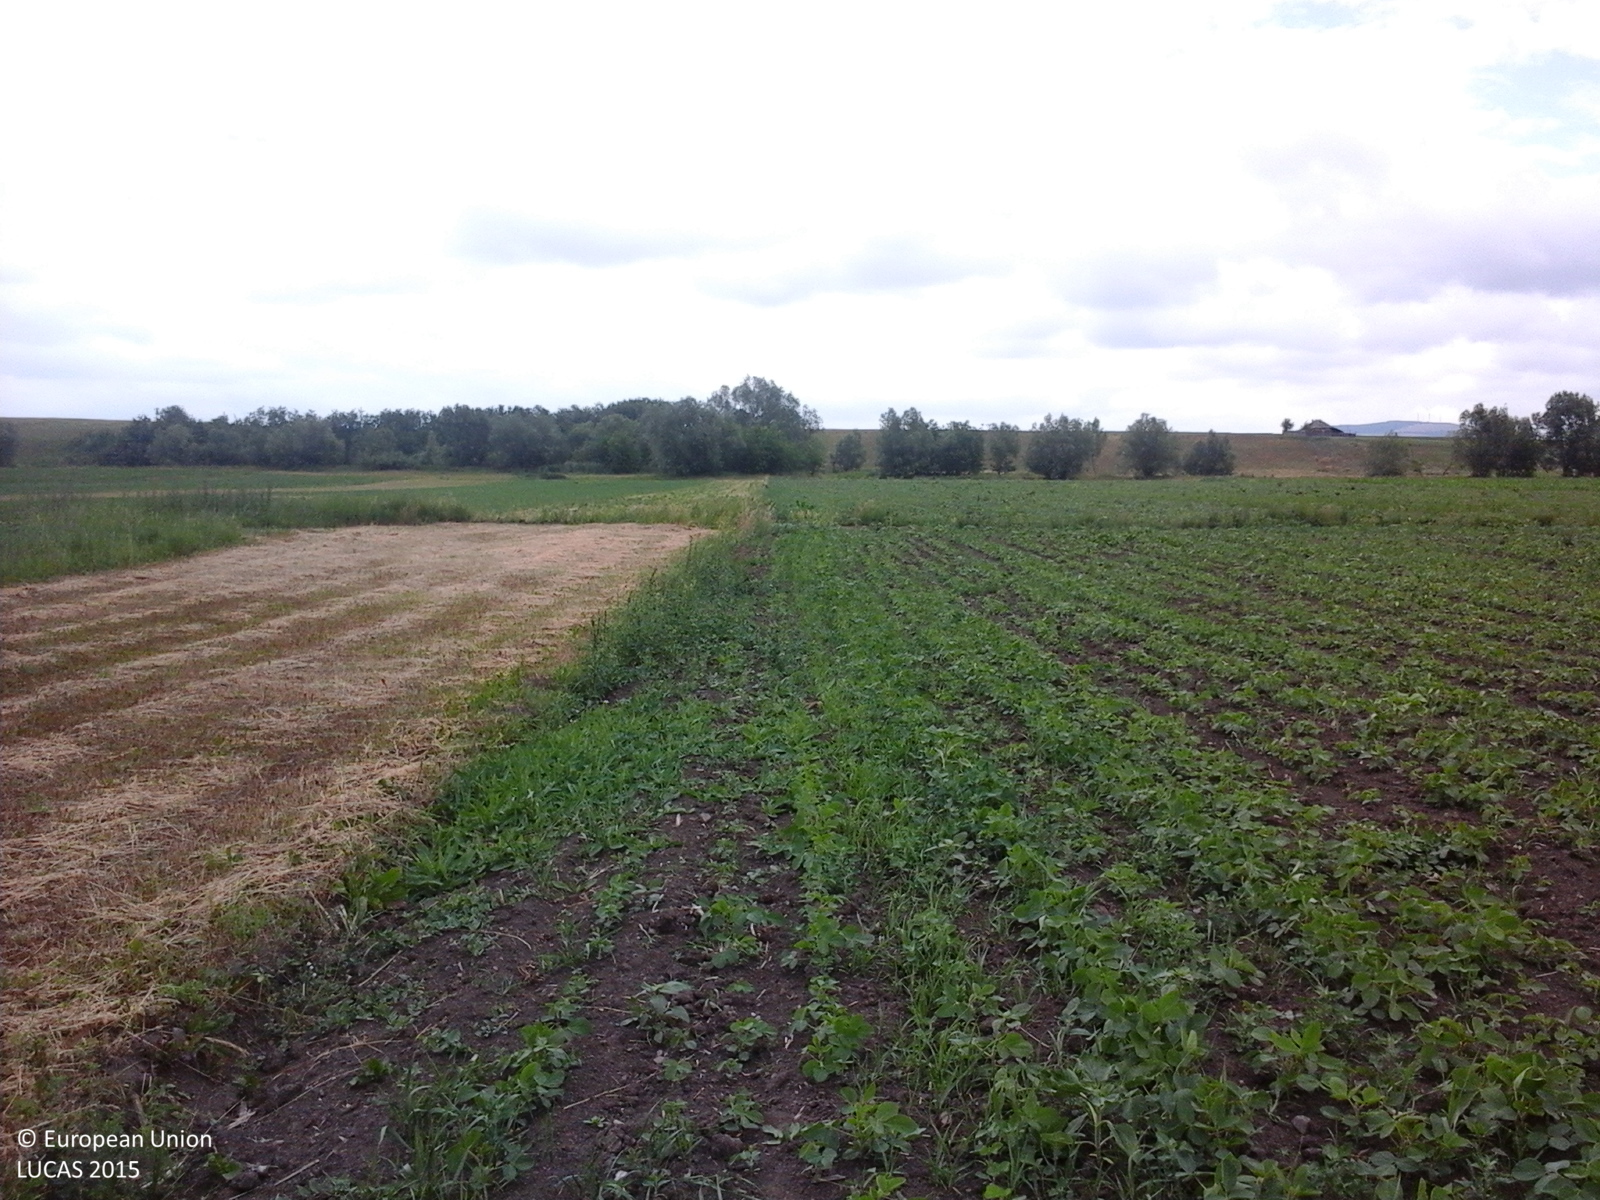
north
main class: Cropland
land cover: Soya
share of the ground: > 75 %
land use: Agriculture (excluding fallow land and kitchen gardens)
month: May
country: RO
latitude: 47.1402
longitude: 26.3400
